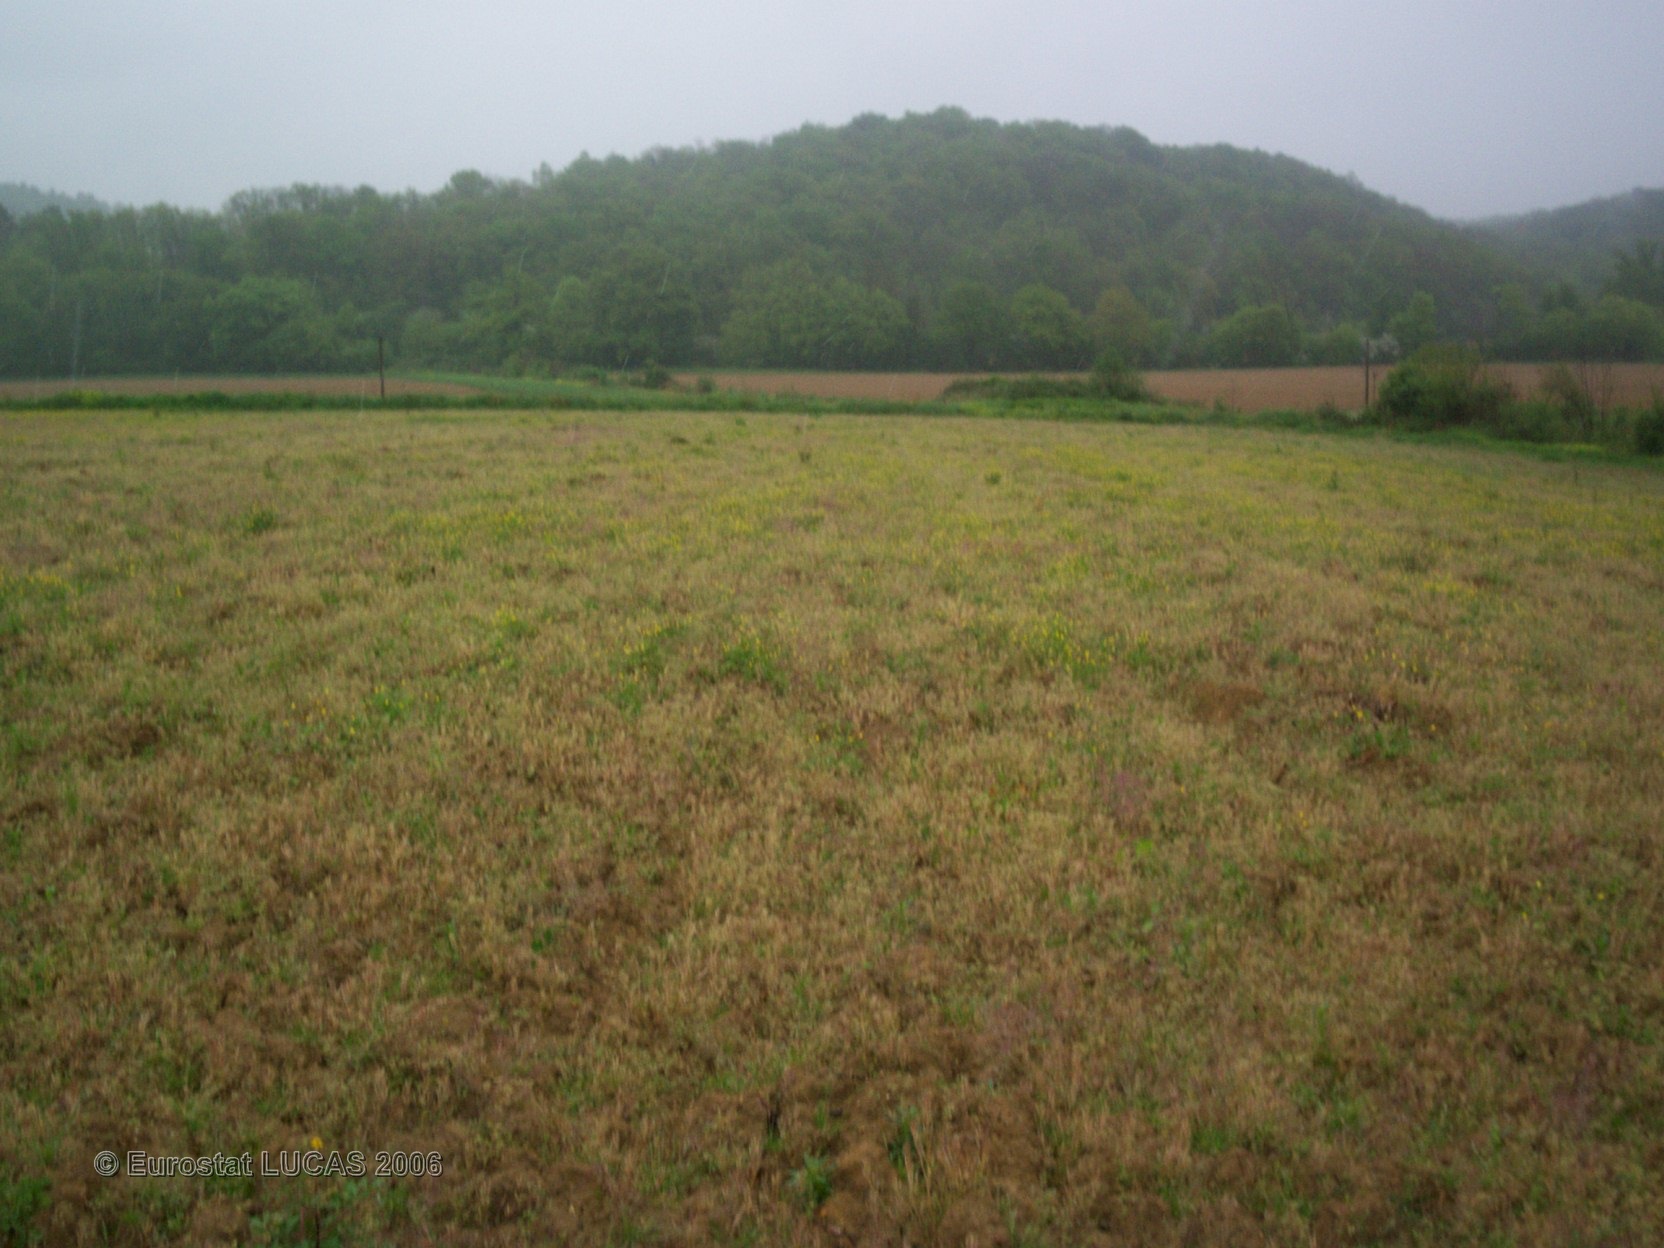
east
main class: Grassland
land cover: Grassland without tree/shrub cover
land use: Fallow land
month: April
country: FR
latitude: 43.5952
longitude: -0.3518
